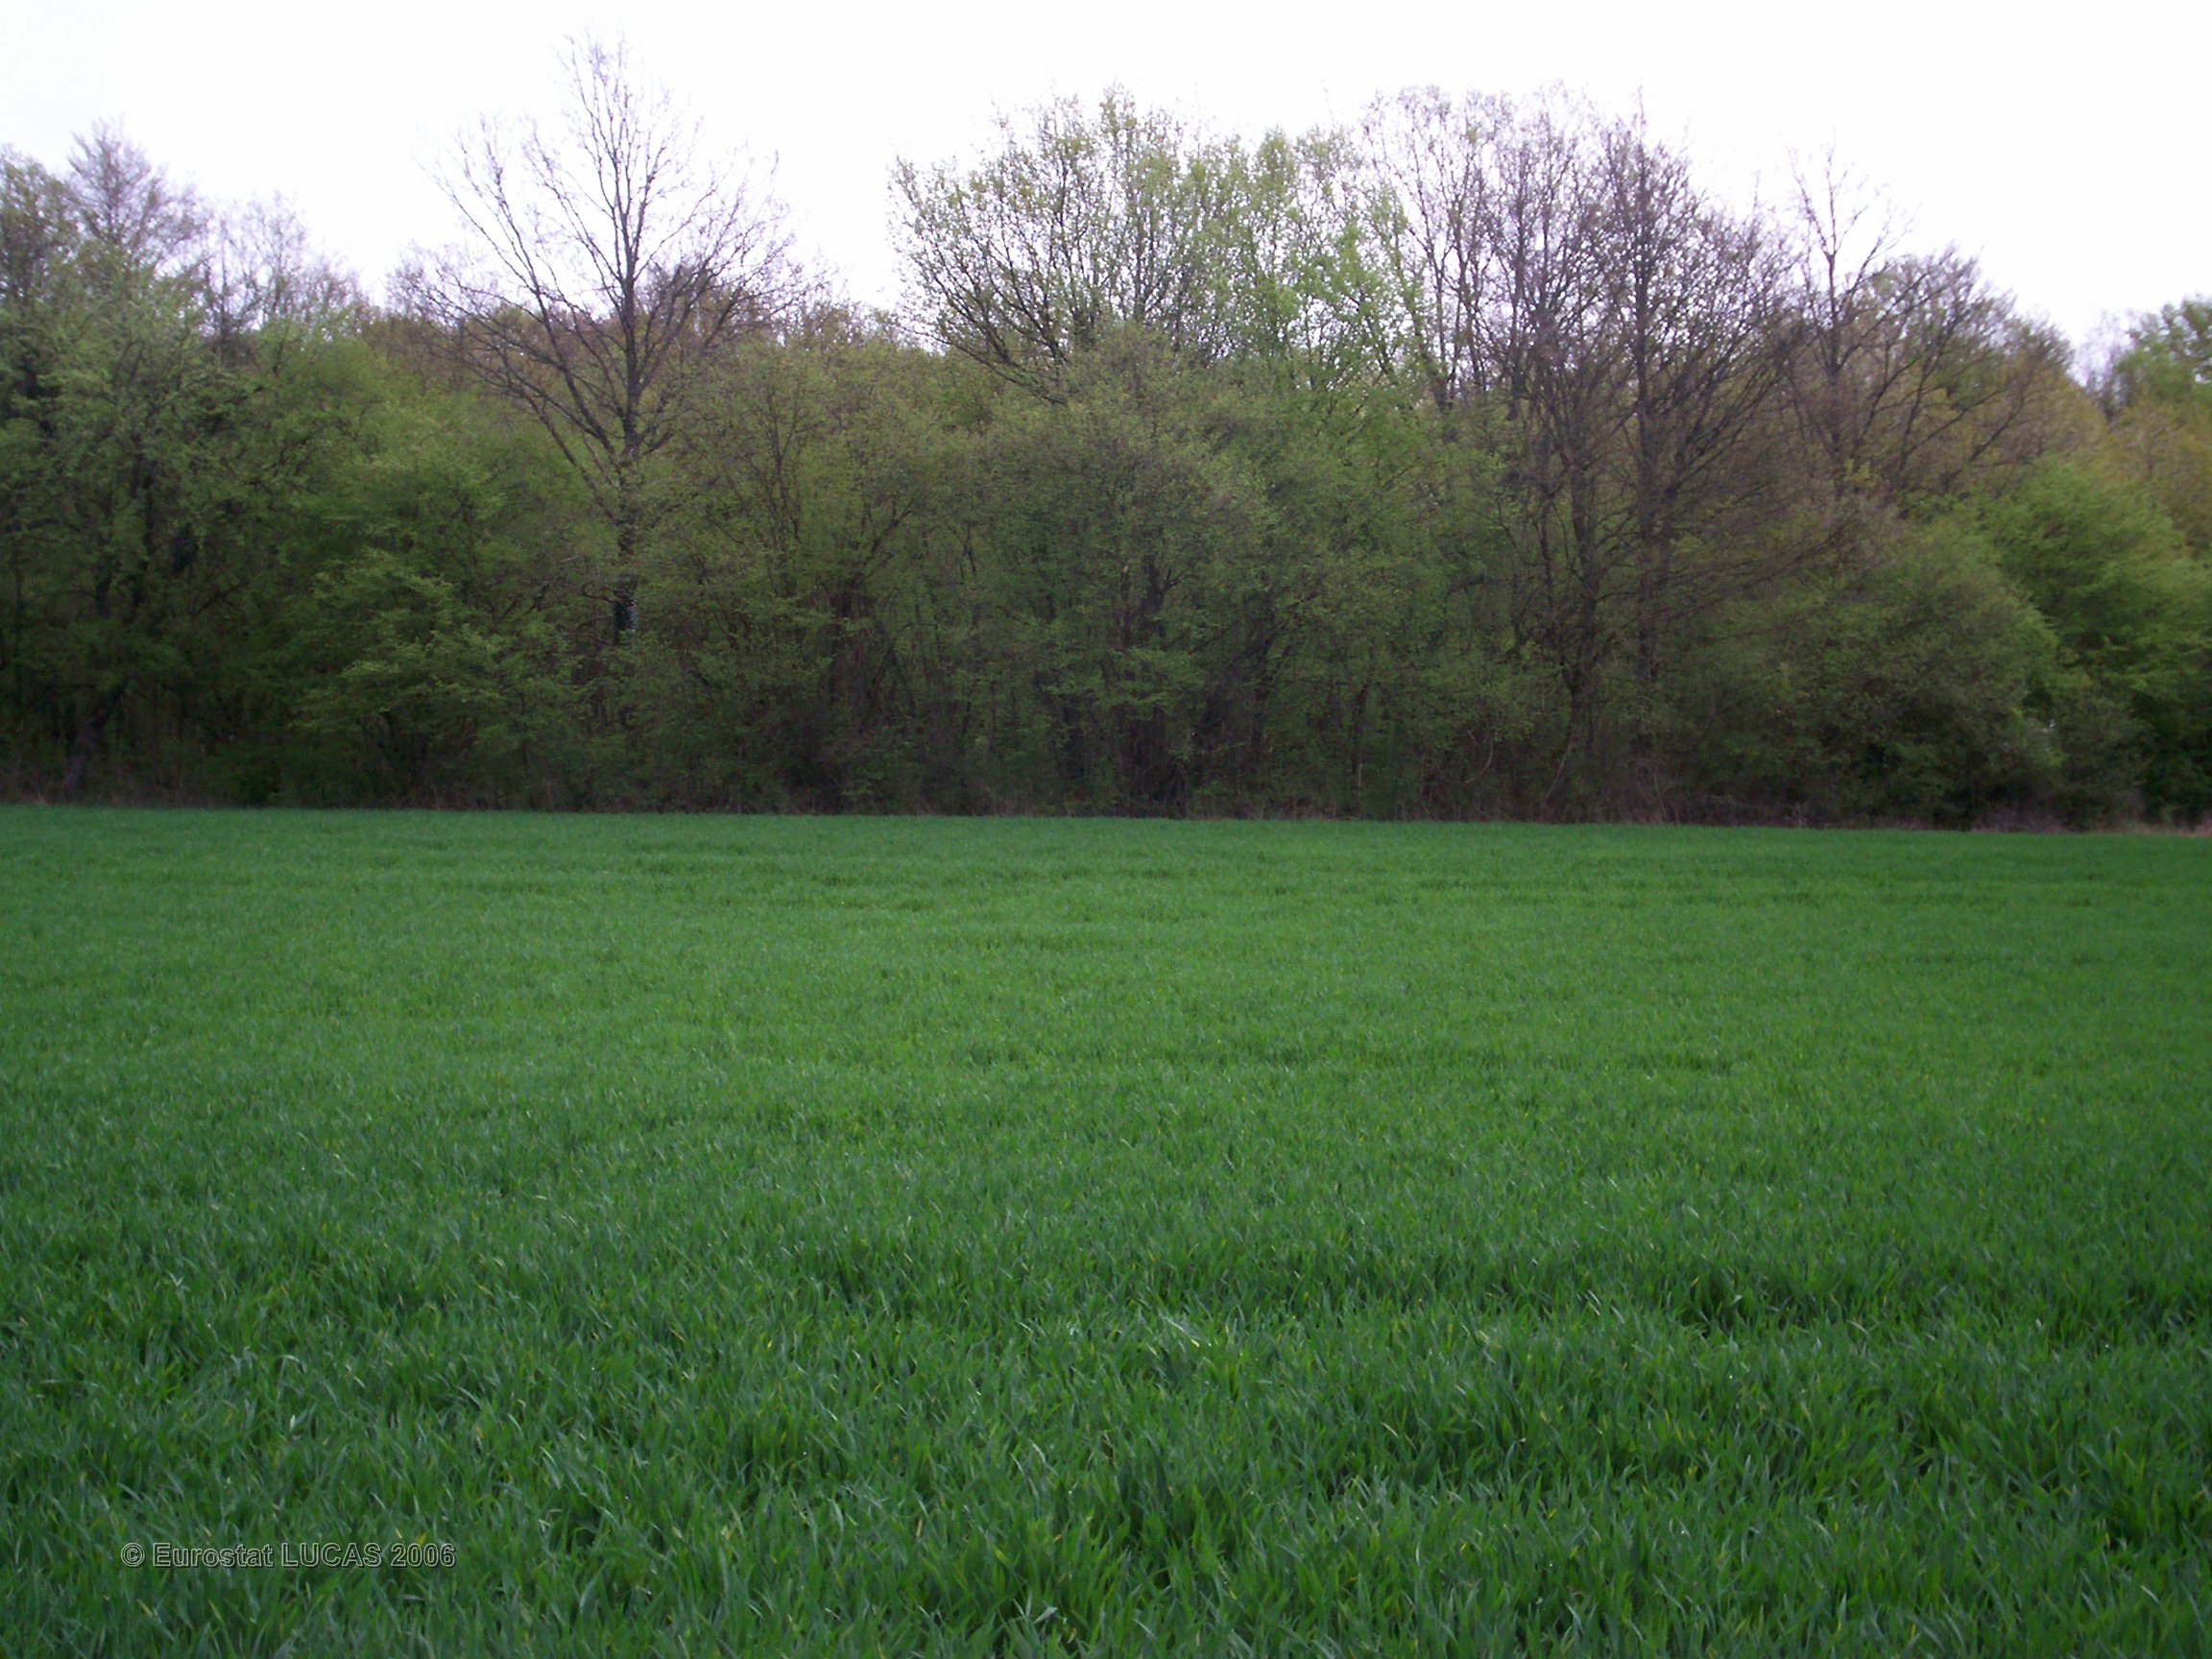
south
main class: Cropland
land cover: Common wheat
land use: Agriculture (excluding fallow land and kitchen gardens)
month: April
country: FR
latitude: 47.6132
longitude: 6.0766
